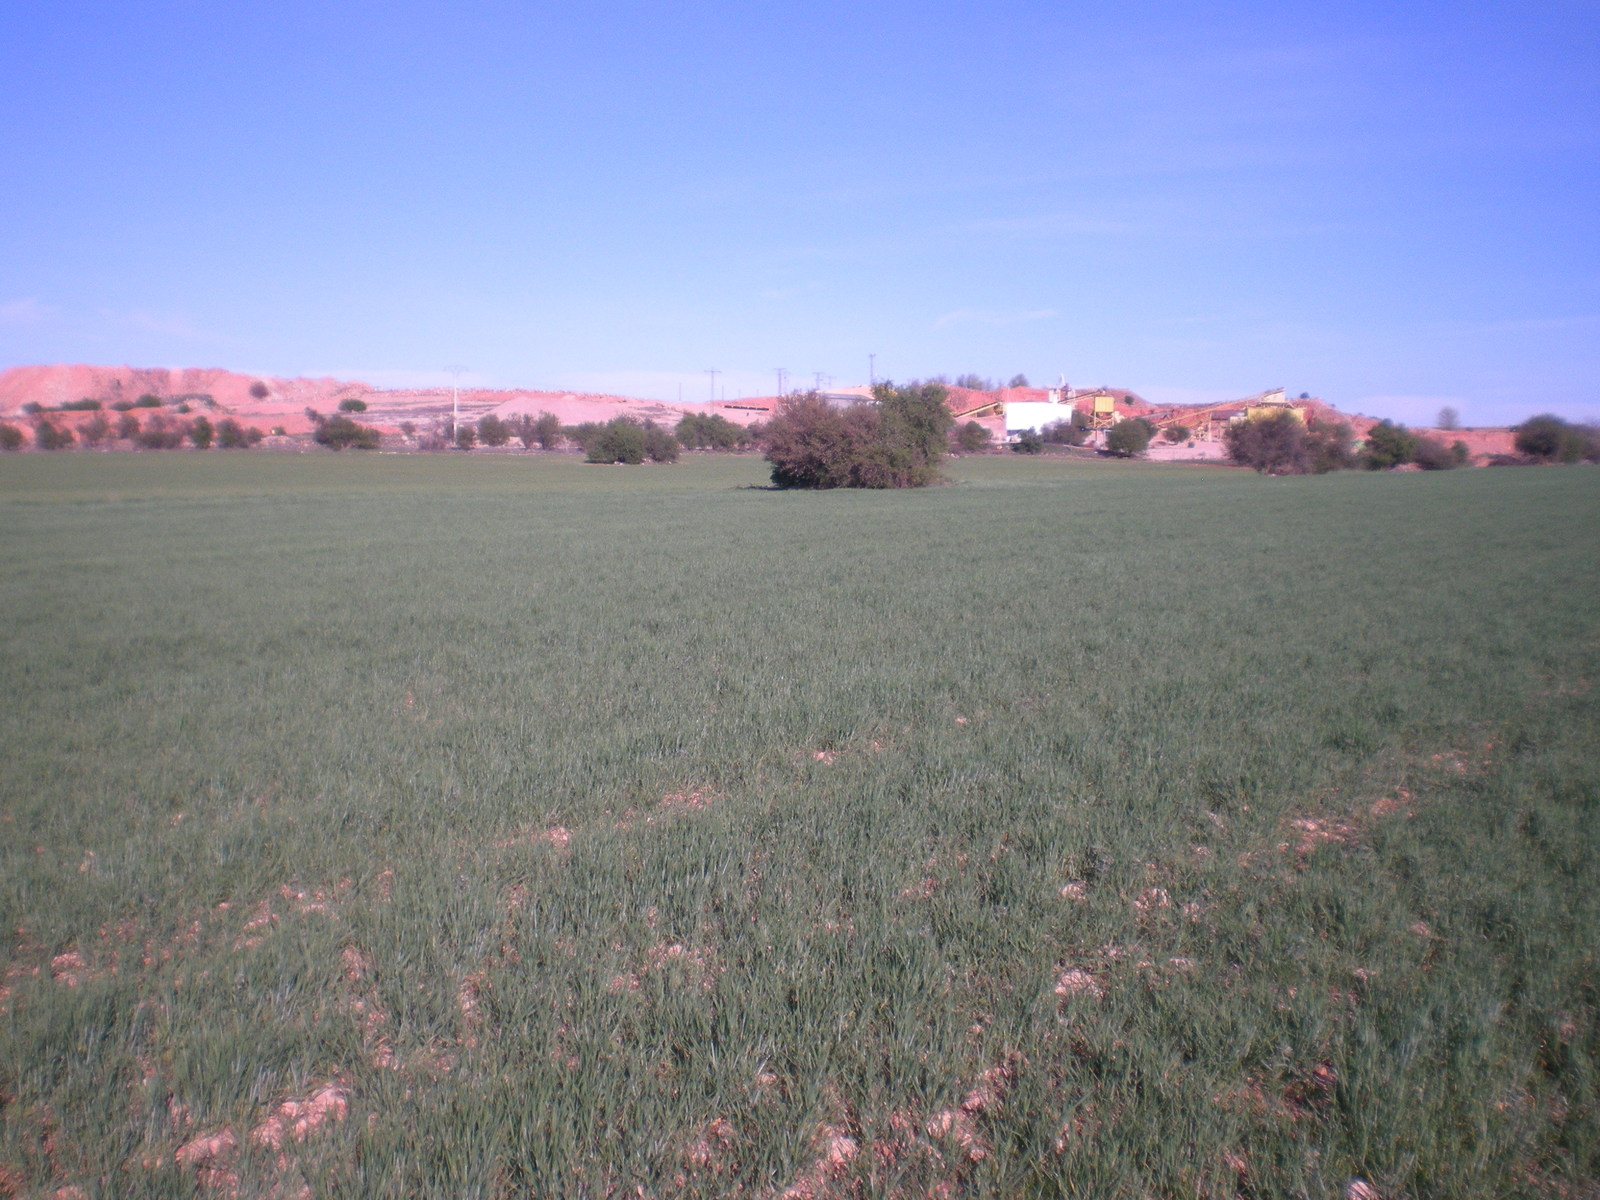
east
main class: Cropland
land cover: Barley
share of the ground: > 75 %
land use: Agriculture (excluding fallow land and kitchen gardens)
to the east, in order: Barley; Single bushes/trees; Grass margins; Barley; Abandoned hedges; Fences; Grass margins; Paved roads, cycling and walking lanes
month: March
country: ES
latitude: 39.0296
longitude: -3.2864
